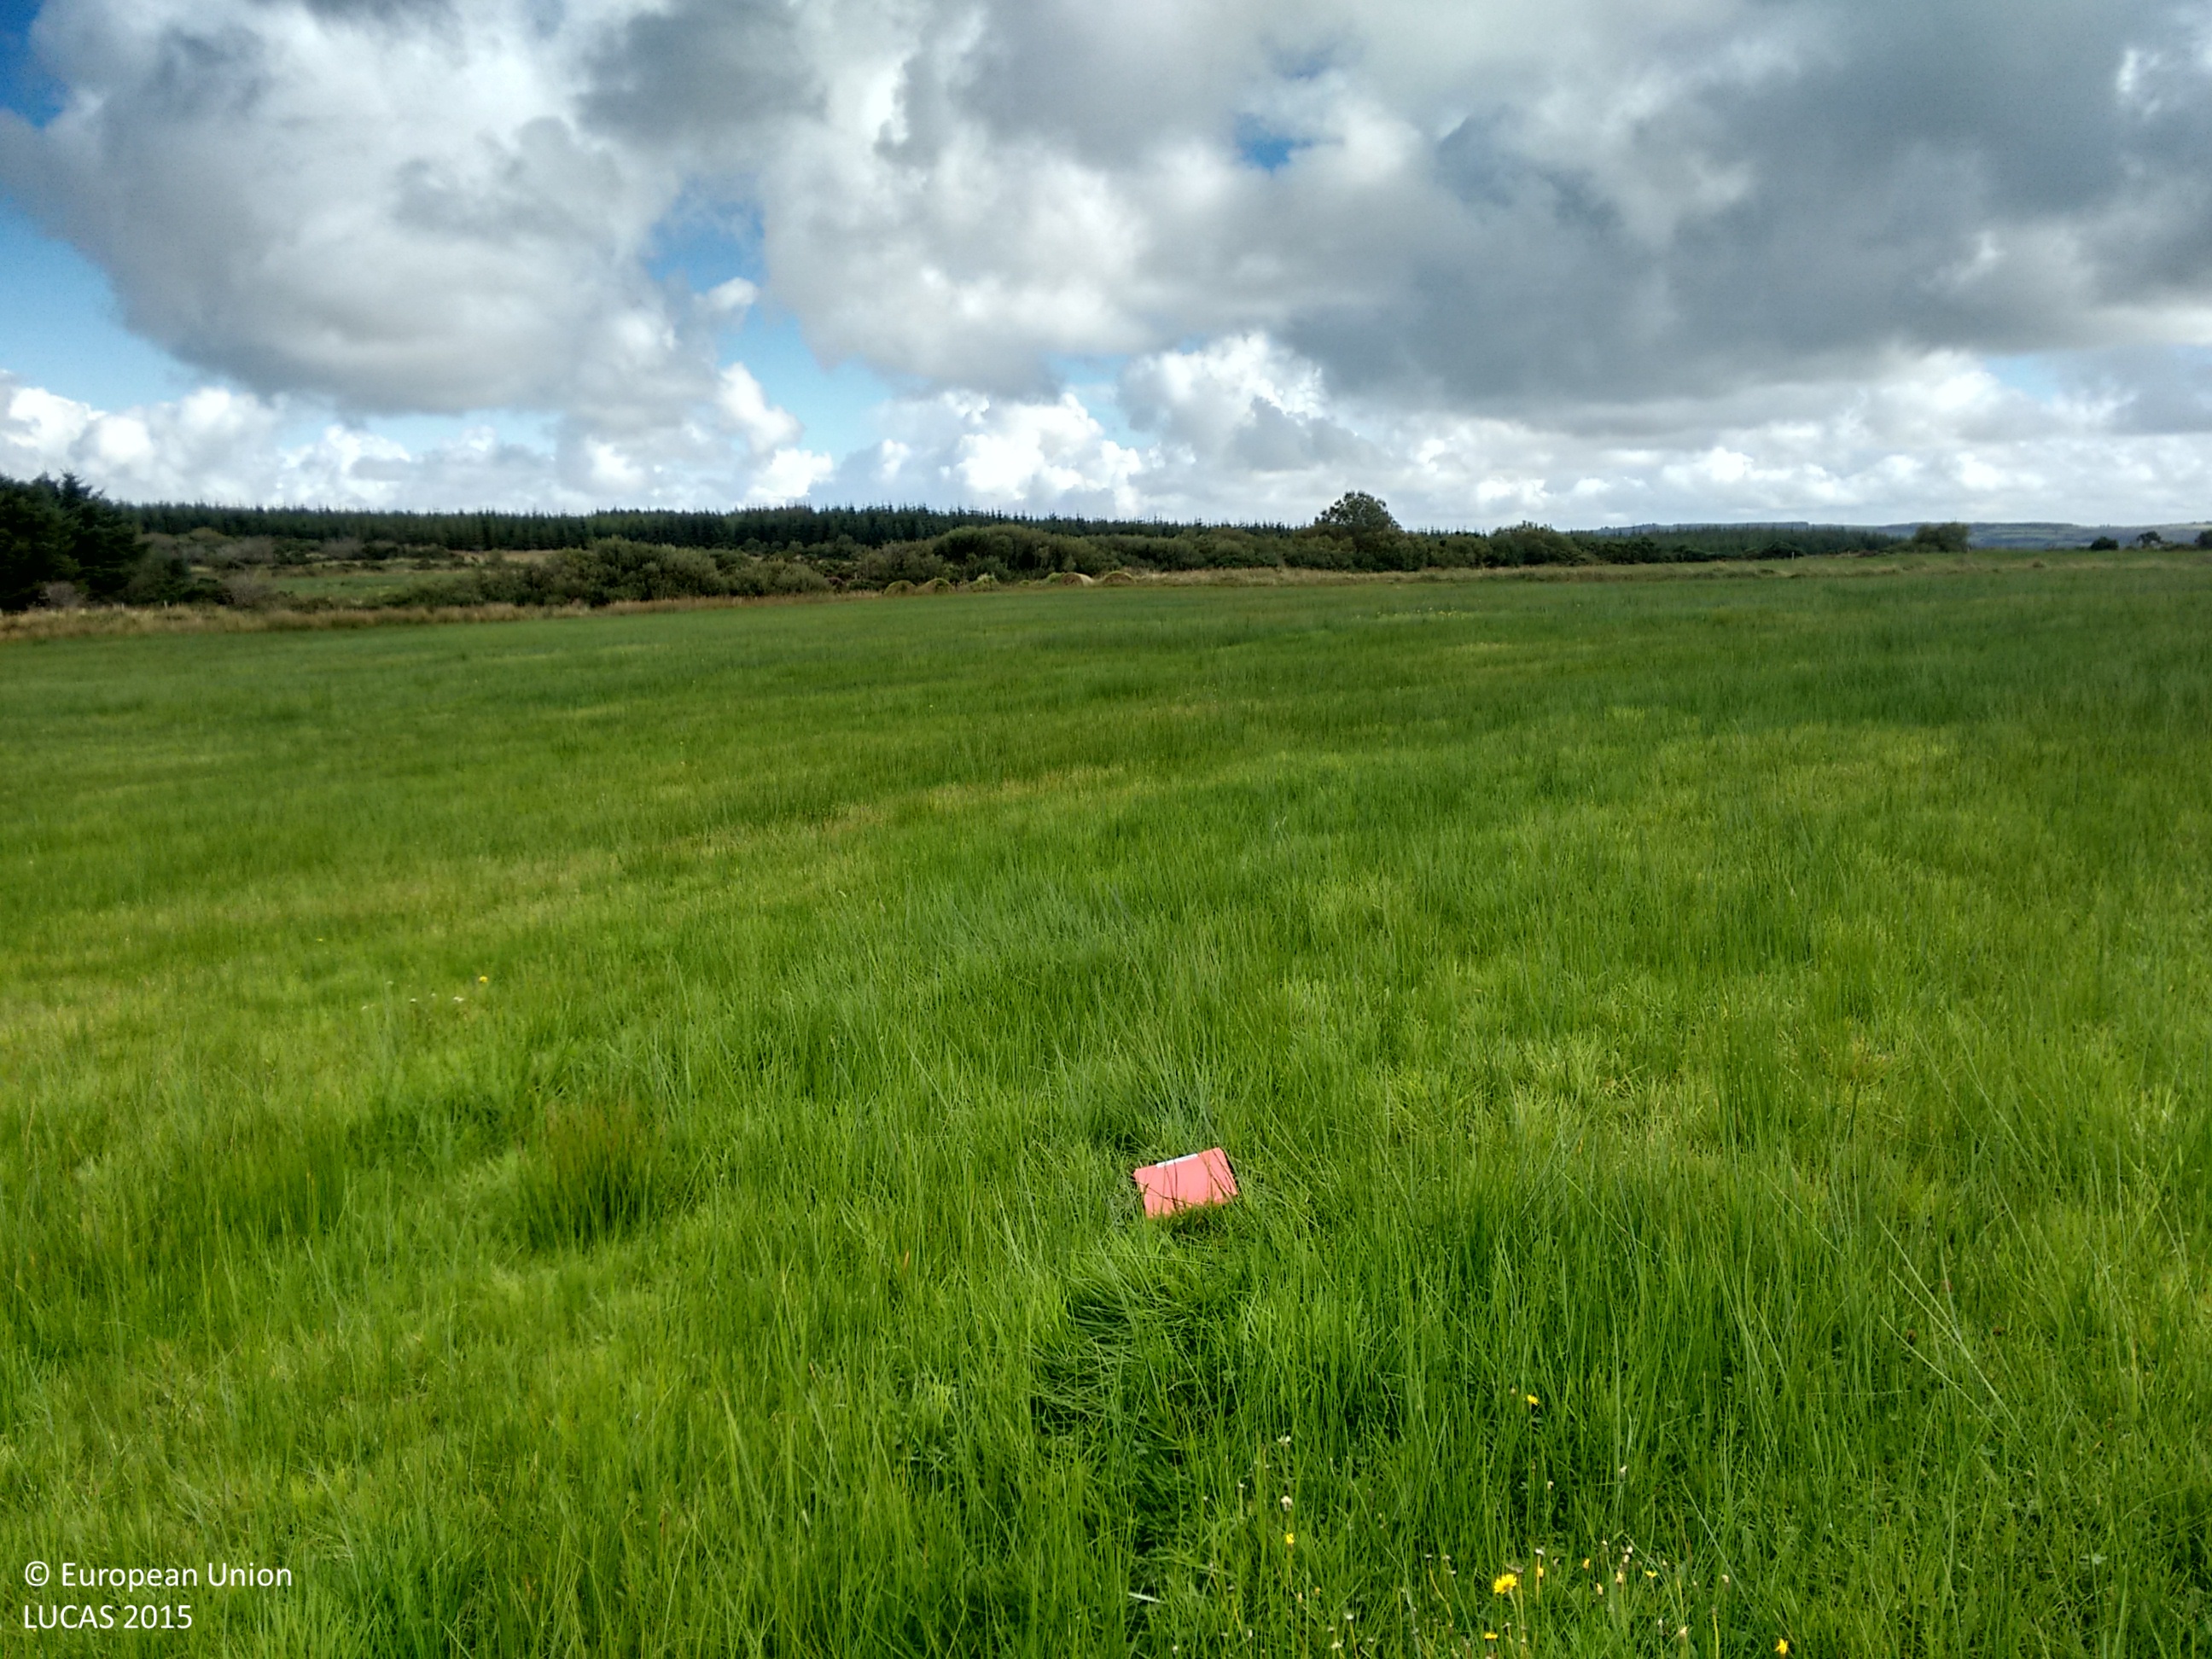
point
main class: Grassland
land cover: Grassland without tree/shrub cover
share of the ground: > 75 %
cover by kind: herbaceous plants 100 %
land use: Agriculture (excluding fallow land and kitchen gardens)
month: September
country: IE
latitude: 52.7460
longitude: -9.2280
